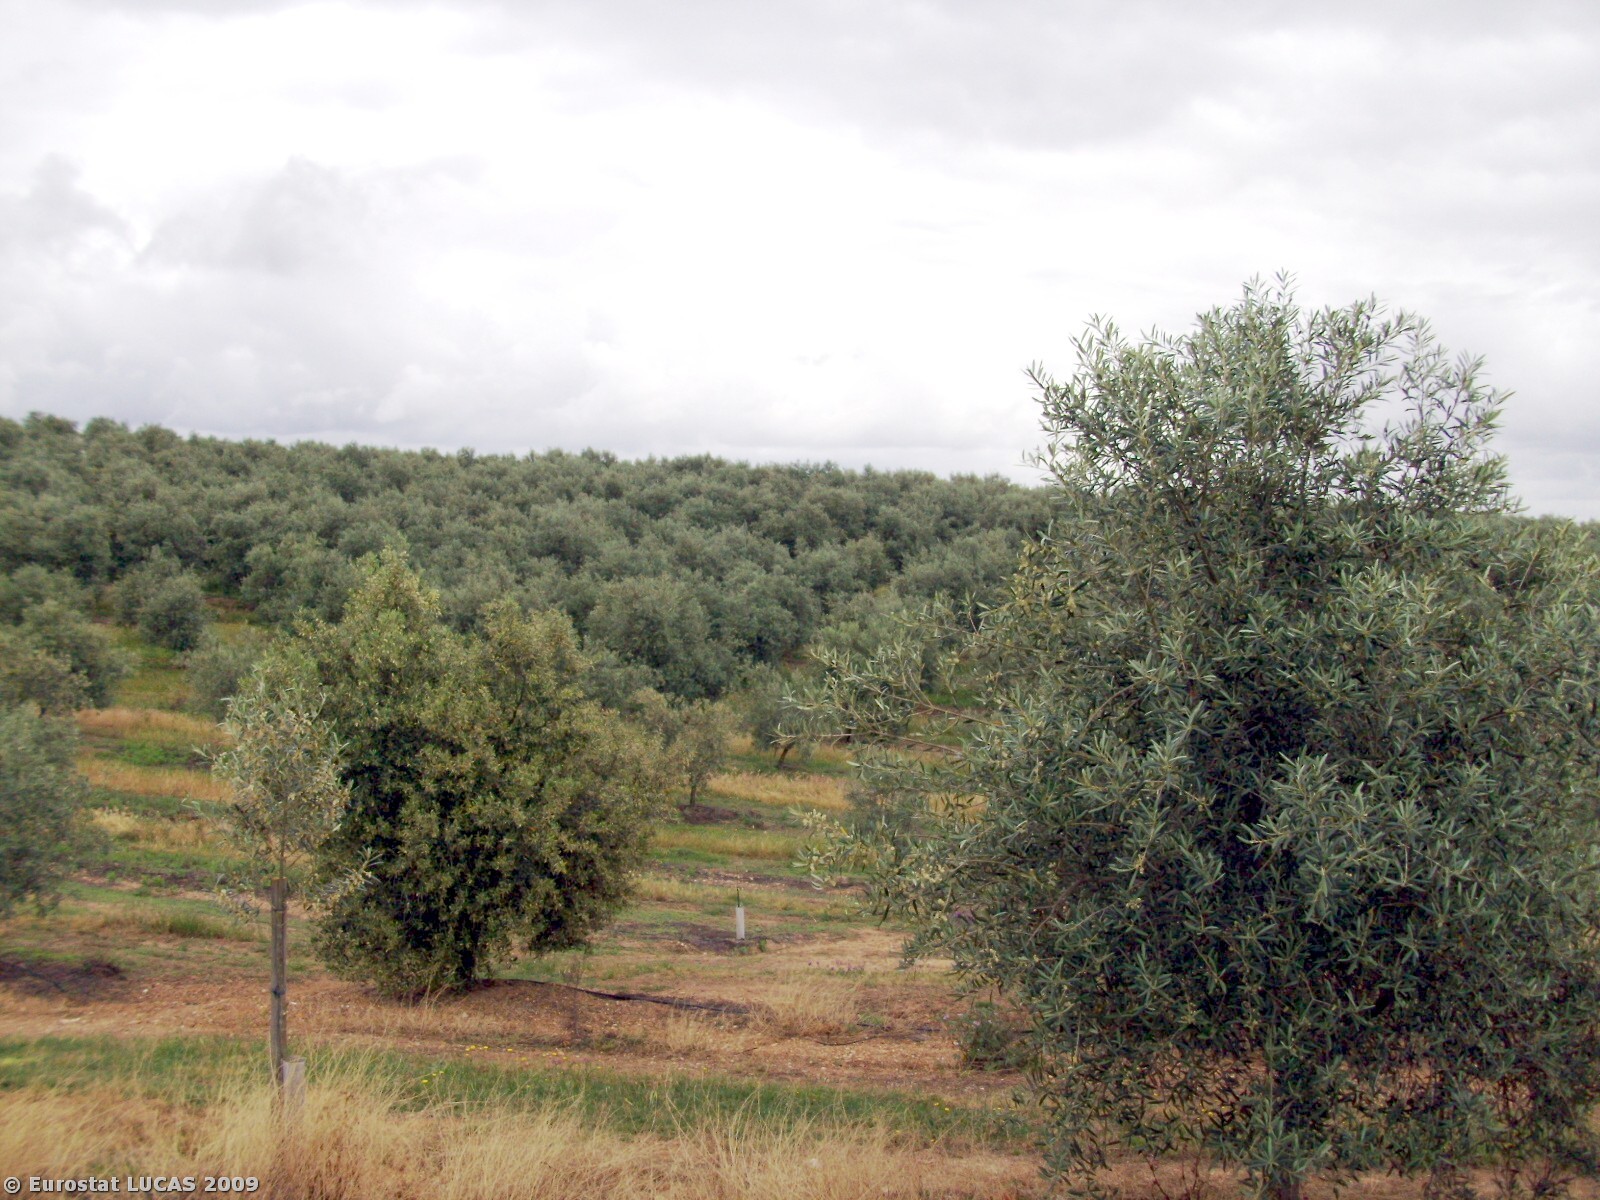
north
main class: Cropland
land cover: Olive groves
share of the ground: 25 - 50 %
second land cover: Spontaneously vegetated surfaces
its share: 50 - 75 %
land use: Agriculture (excluding fallow land and kitchen gardens)
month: May
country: PT
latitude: 39.1934
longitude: -7.8217
